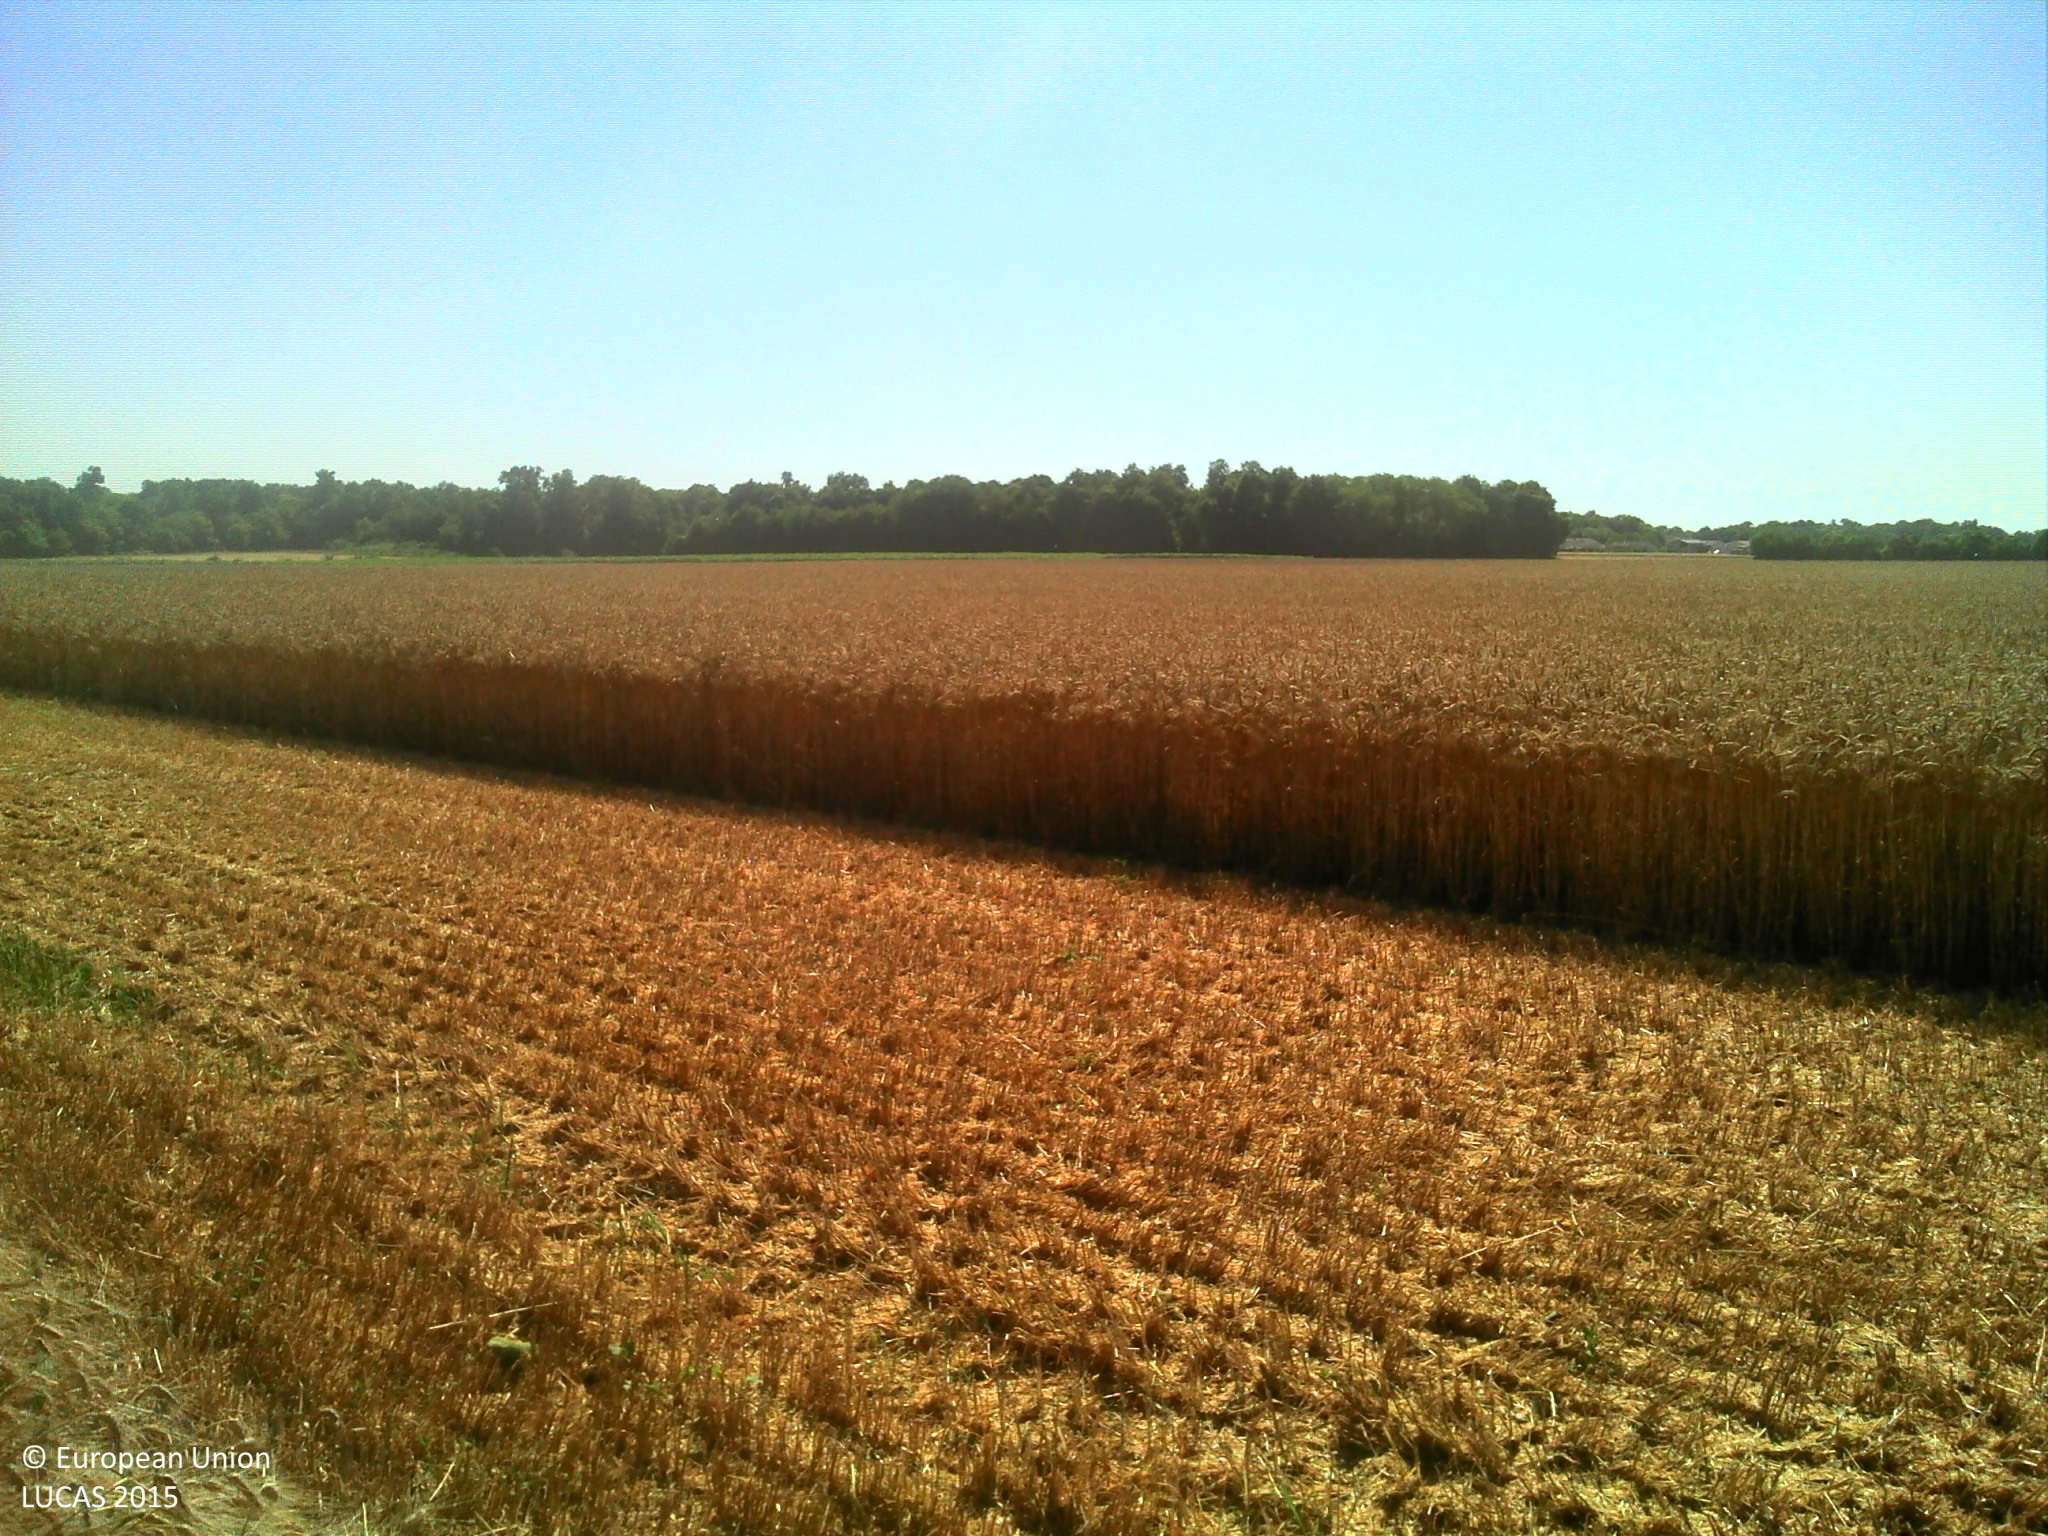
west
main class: Cropland
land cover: Common wheat
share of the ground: > 75 %
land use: Agriculture (excluding fallow land and kitchen gardens)
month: June
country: FR
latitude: 45.5846
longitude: -0.6227
